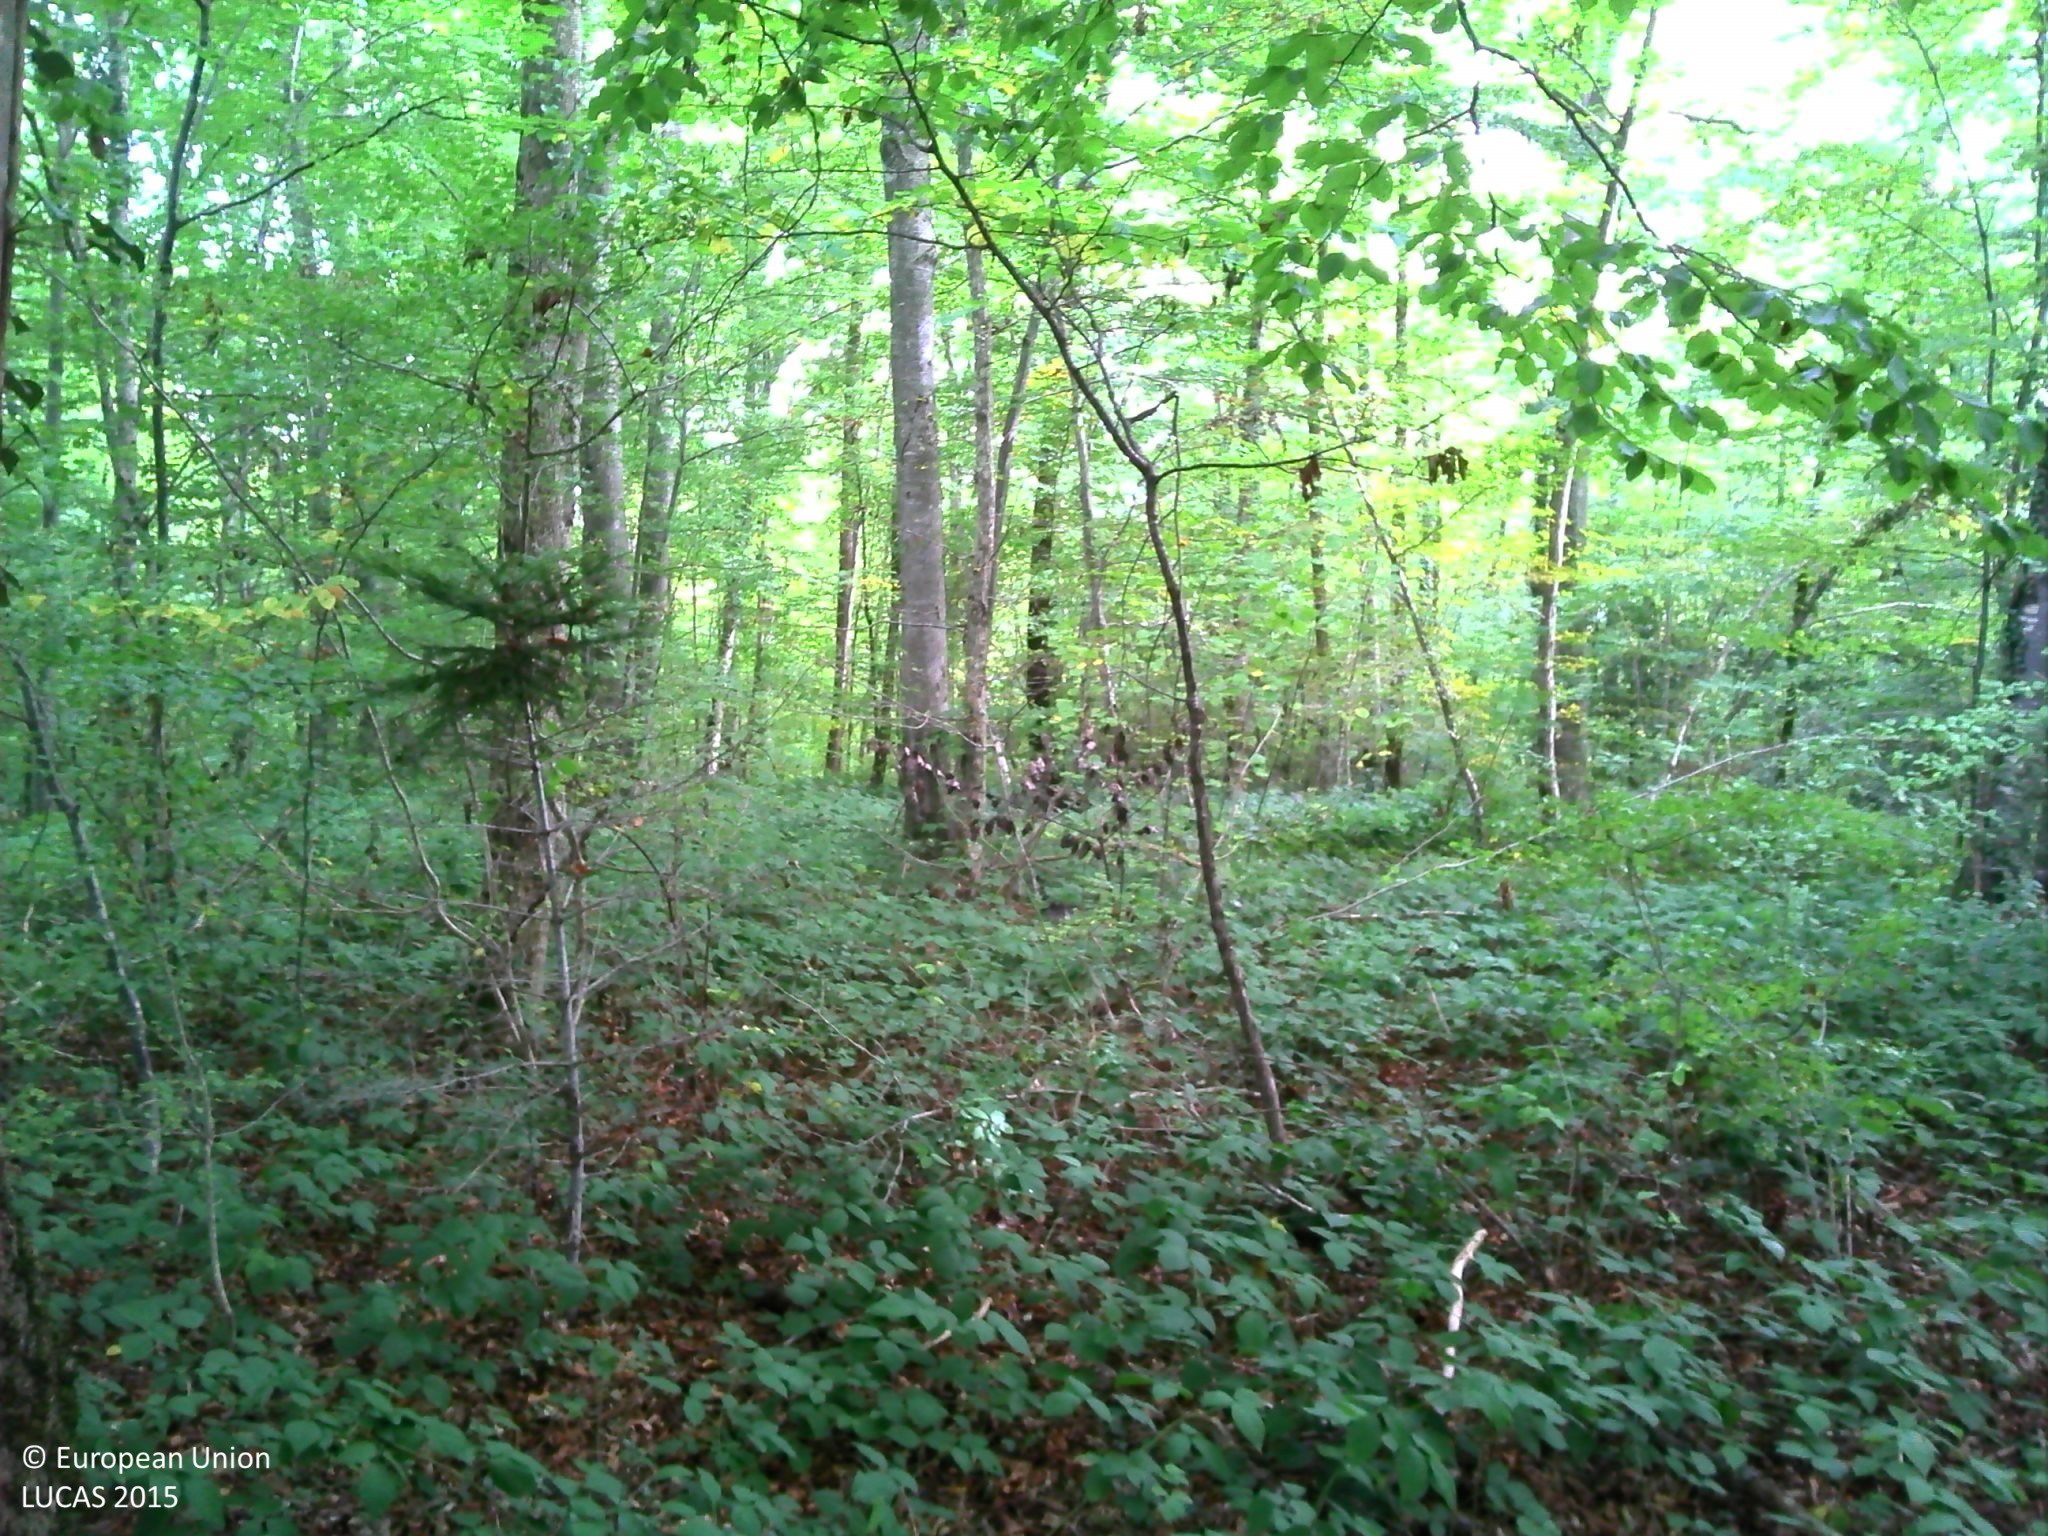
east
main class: Woodland
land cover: Broadleaved woodland
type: beech forest
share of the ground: > 75 %
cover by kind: broadleaved forest trees 90 %, herbaceous plants 5 %, unconsolidated bare surface 5 %
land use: Forestry
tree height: > 5 m
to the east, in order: Broadleaved woodland; Tracks; Broadleaved woodland; Tracks; Broadleaved woodland; Grass margins; Ditches and canals; Grass margins; Paved roads, cycling and walking lanes; Broadleaved woodland; Tracks; Broadleaved woodland
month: October
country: FR
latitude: 47.0749
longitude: 6.1434
